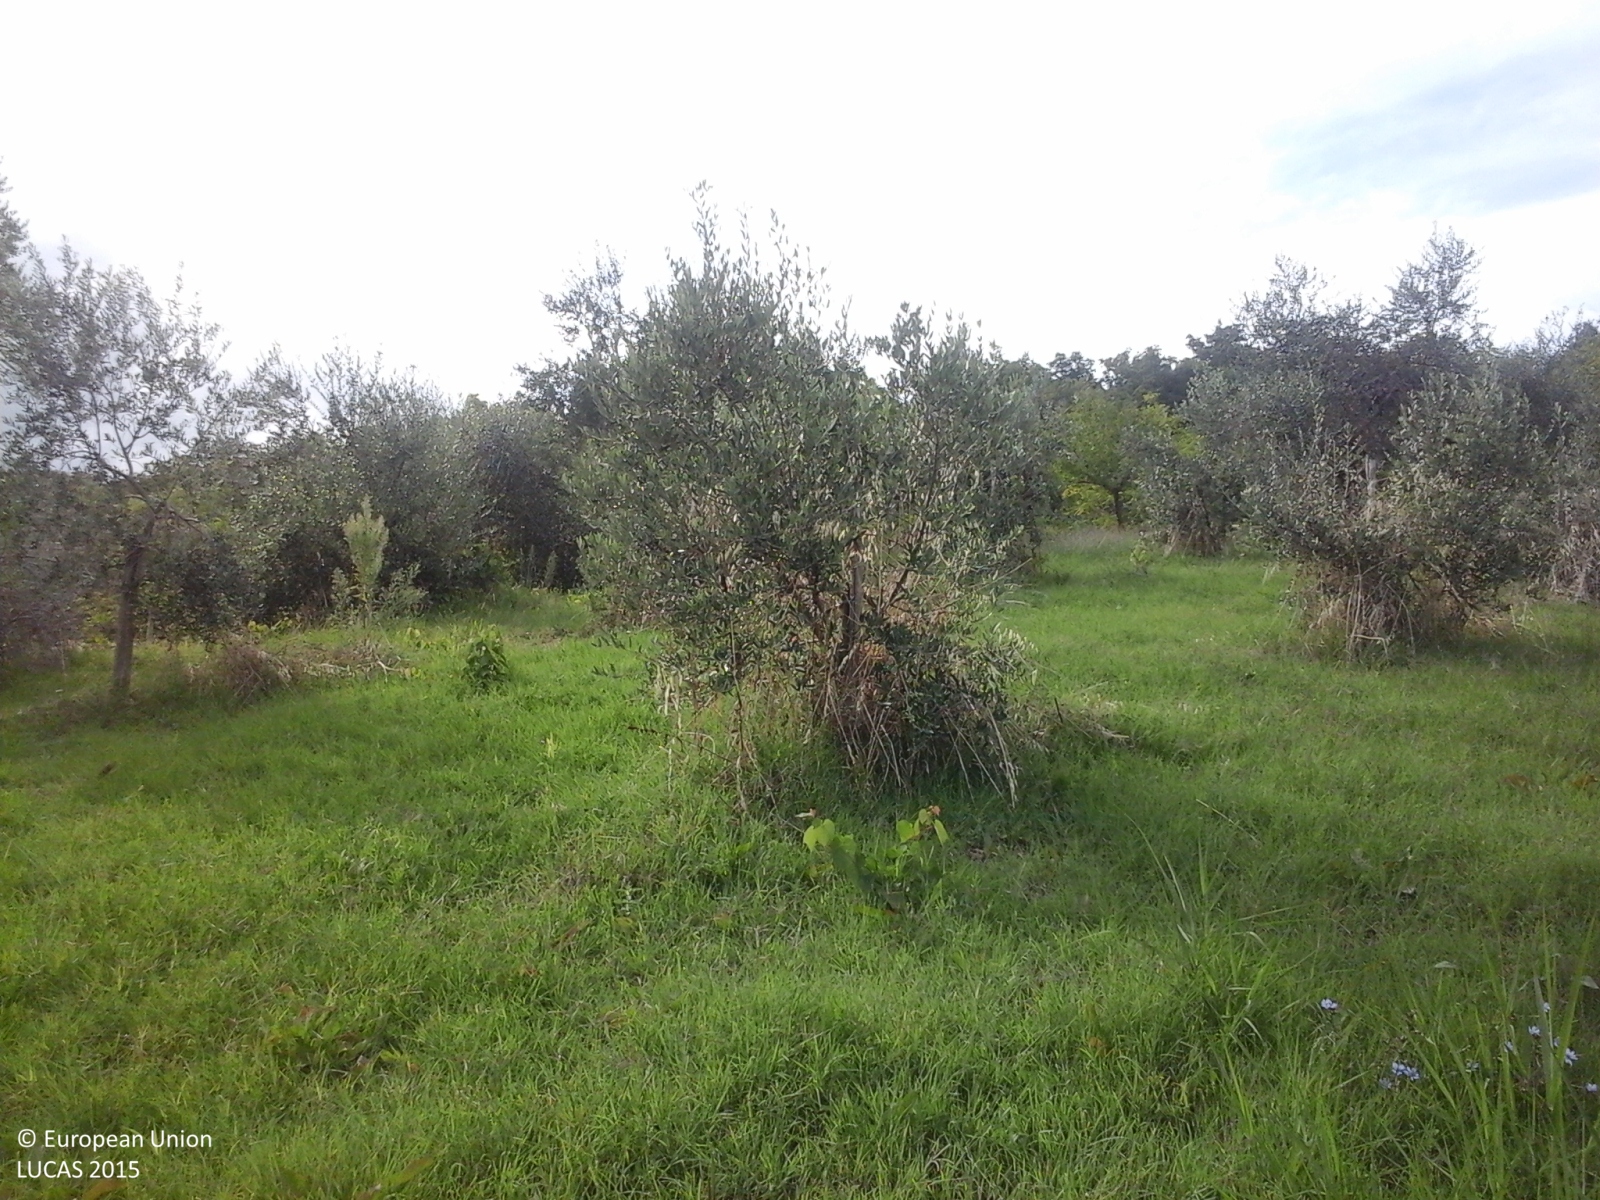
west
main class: Woodland
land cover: Broadleaved woodland
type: thermophilous deciduous forest
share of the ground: > 75 %
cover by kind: broadleaved forest trees 80 %, shrubs 10 %, herbaceous plants 10 %
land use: Semi-natural and natural areas not in use
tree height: > 5 m
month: September
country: IT
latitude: 42.5646
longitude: 13.8014
